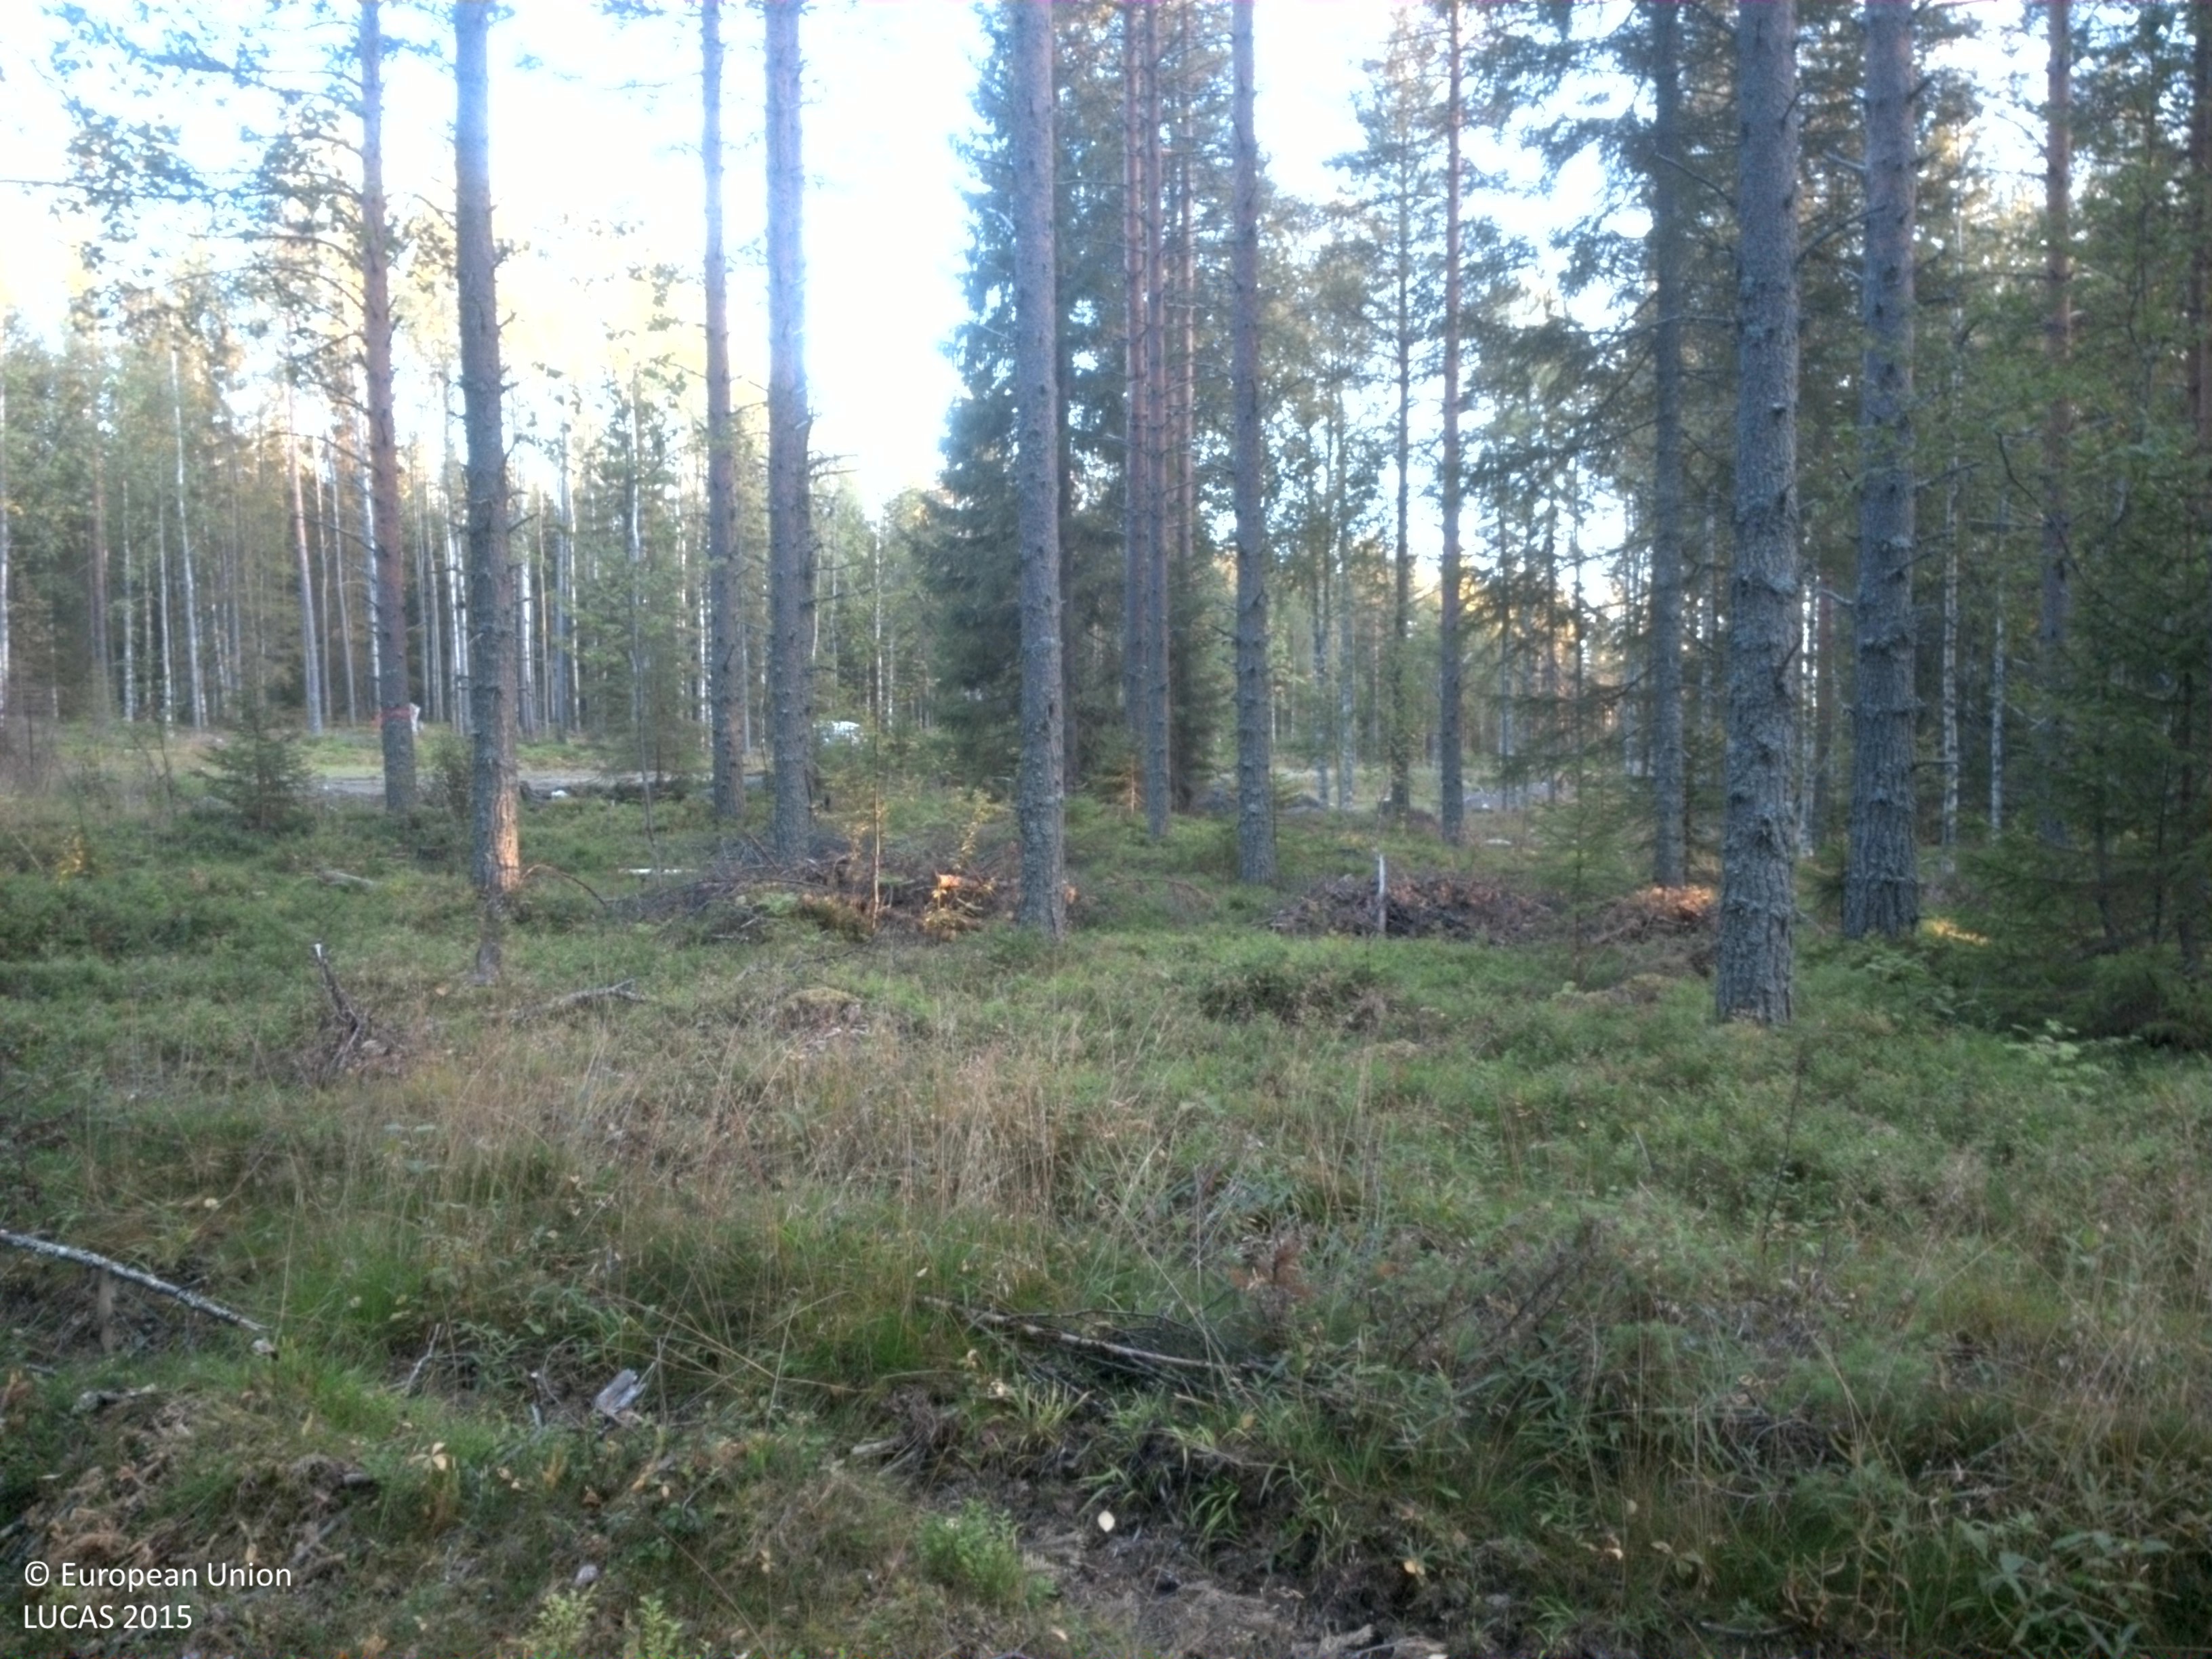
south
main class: Woodland
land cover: Pine dominated coniferous woodland
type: boreal forest
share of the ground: 25 - 50 %
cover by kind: coniferous forest trees 45 %, shrubs 45 %, broadleaved forest trees 5 %, lichens and mosses 5 %
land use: Forestry
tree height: > 5 m
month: September
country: SE
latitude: 64.3566
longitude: 19.6867
